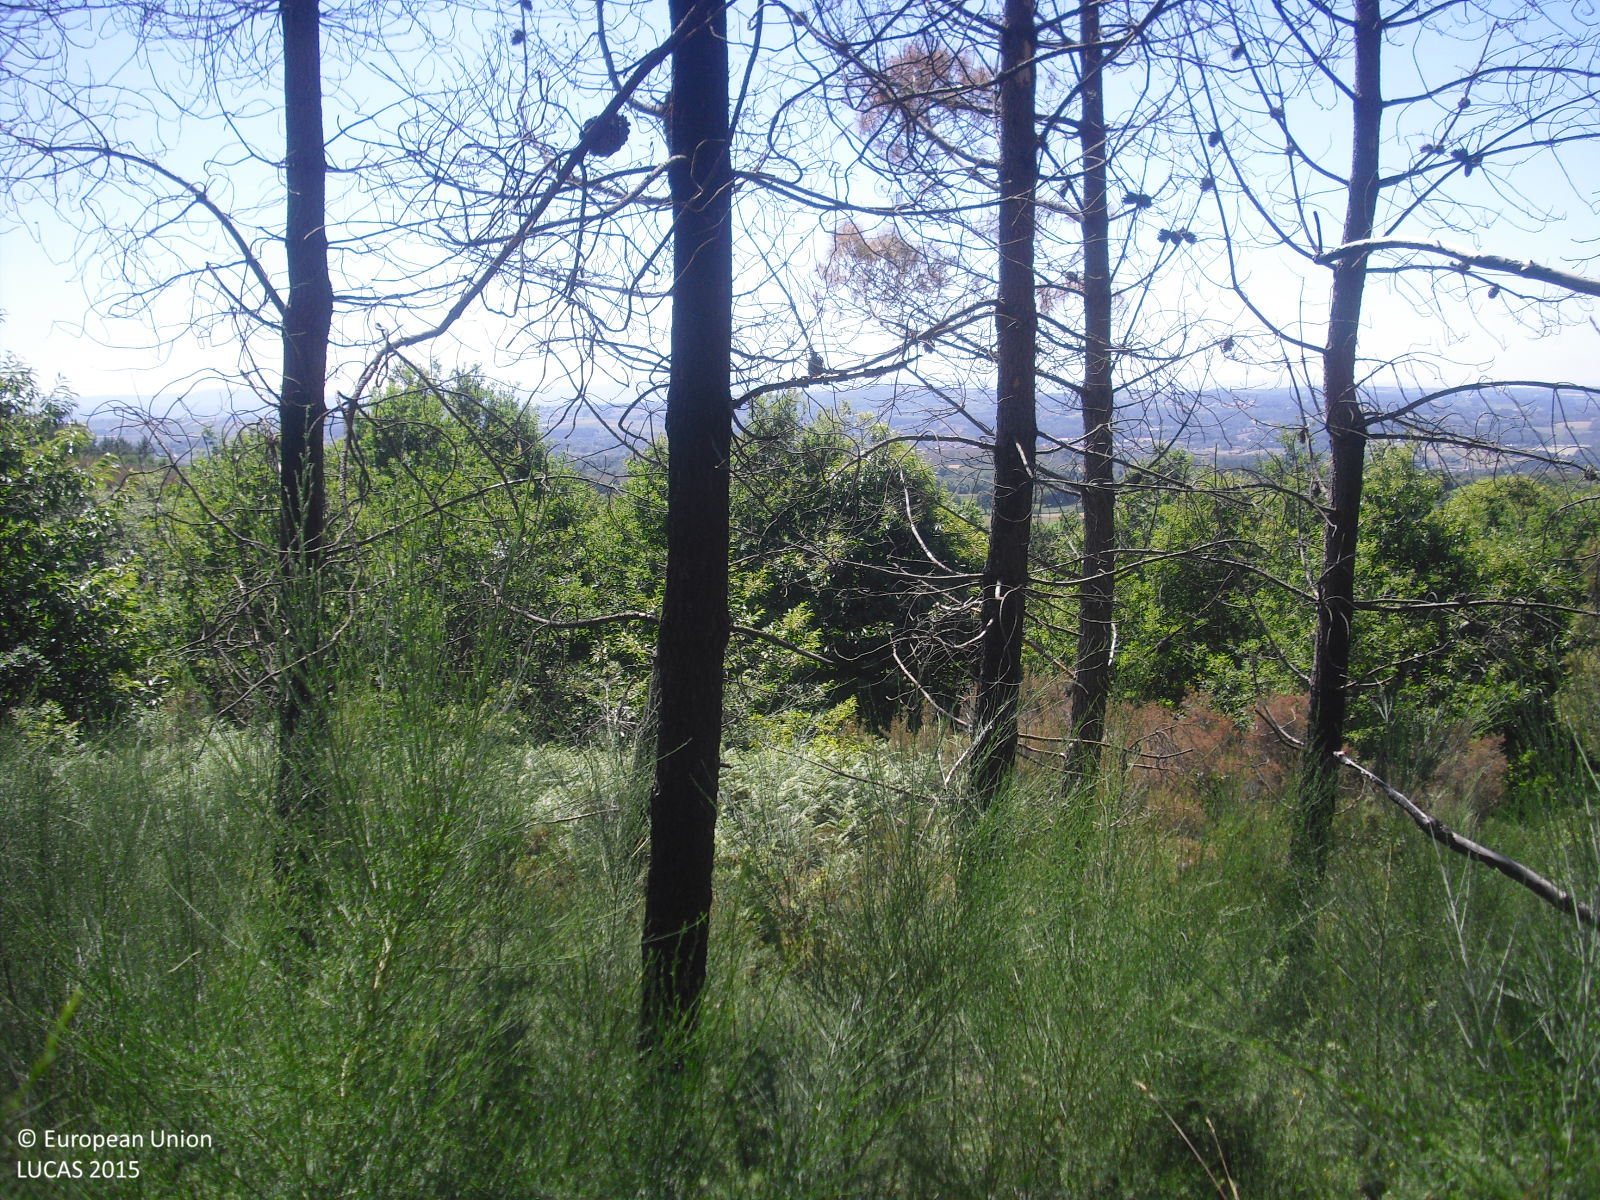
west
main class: Woodland
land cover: Pine dominated coniferous woodland
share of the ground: 10 - 25 %
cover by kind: shrubs 80 %, coniferous forest trees 20 %
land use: Forestry
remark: Burnt area
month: June
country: ES
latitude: 42.6270
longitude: -7.9213
